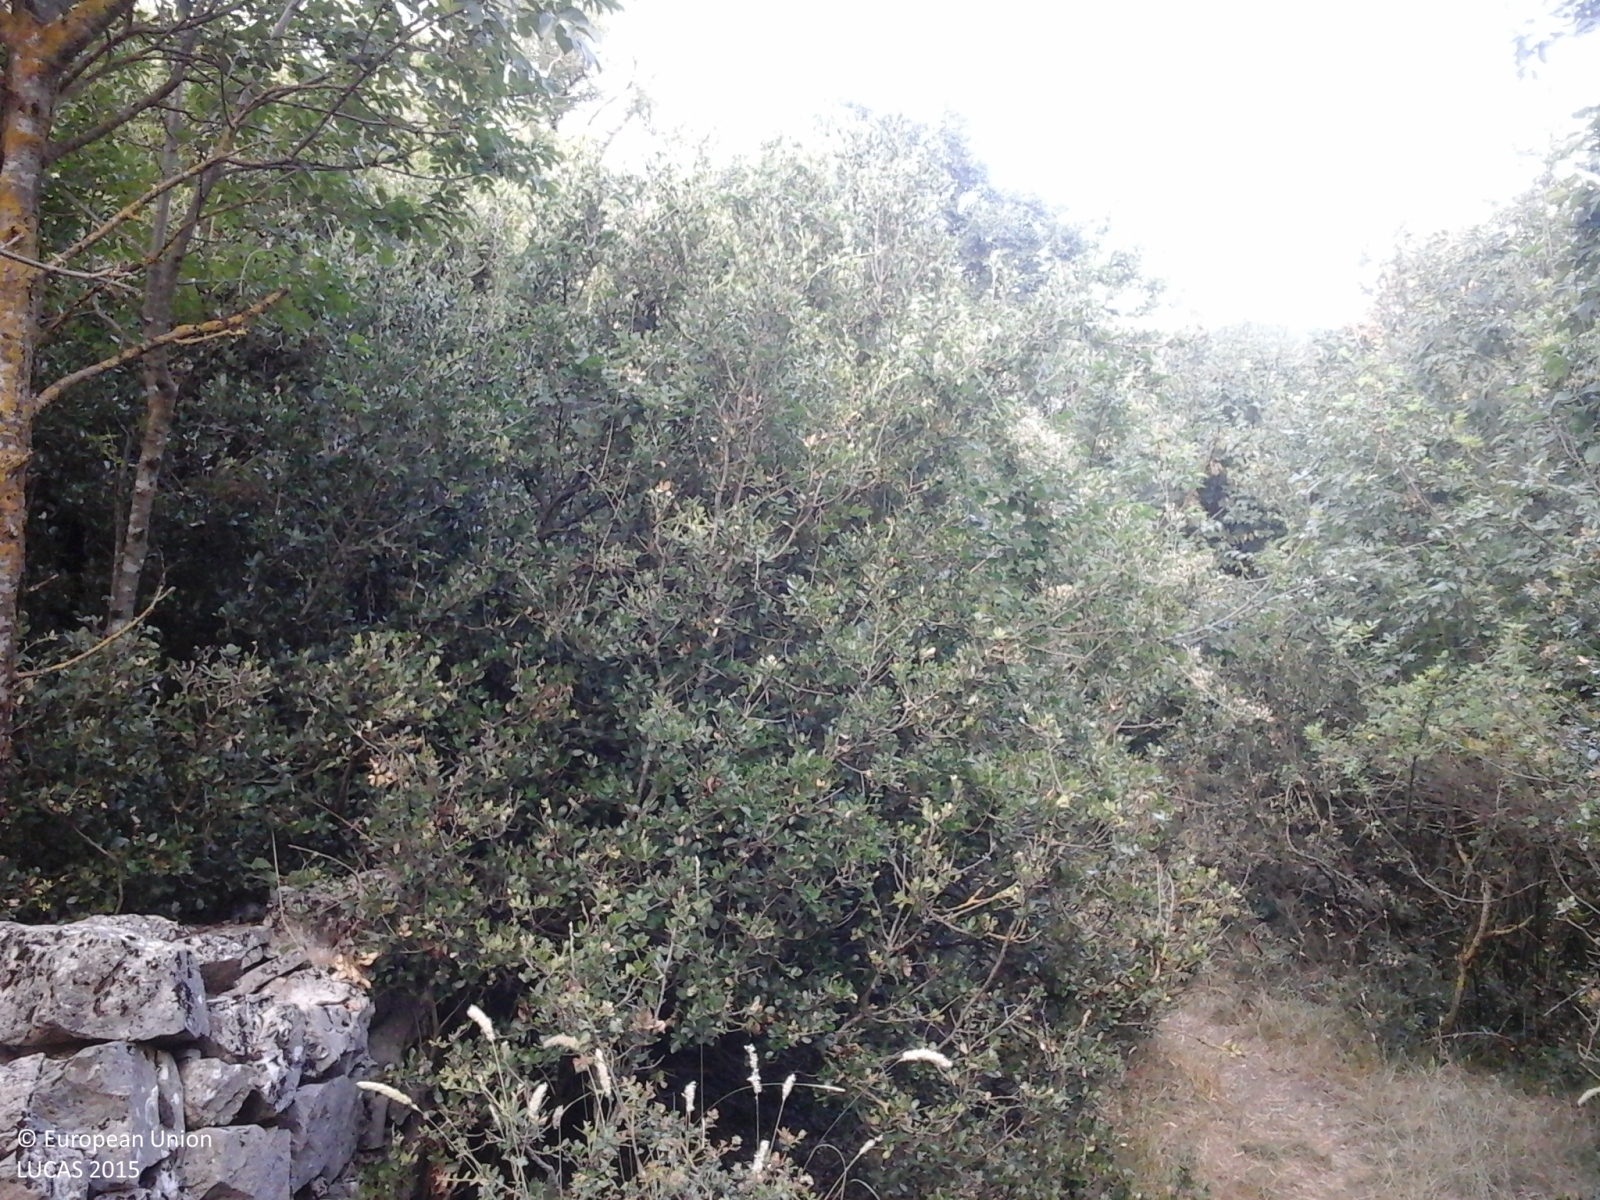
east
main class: Woodland
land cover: Broadleaved woodland
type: broadleaved evergreen forest
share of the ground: > 75 %
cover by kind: broadleaved forest trees 75 %, shrubs 15 %, herbaceous plants 10 %
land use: Semi-natural and natural areas not in use
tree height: > 5 m
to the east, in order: Broadleaved woodland; Dry stone walls; Broadleaved woodland; Dry stone walls; Broadleaved woodland; Dry stone walls; Grassland with sparse tree/shrub cover; Dry stone walls; Abandoned hedges; Spontaneously vegetated surfaces; Electric lines; Spontaneously vegetated surfaces; Abandoned hedges; Spontaneously vegetated surfaces; Dry stone walls; Abandoned hedges; Artificial constructions in urban areas
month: July
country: GR
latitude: 39.5735
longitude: 21.0026
